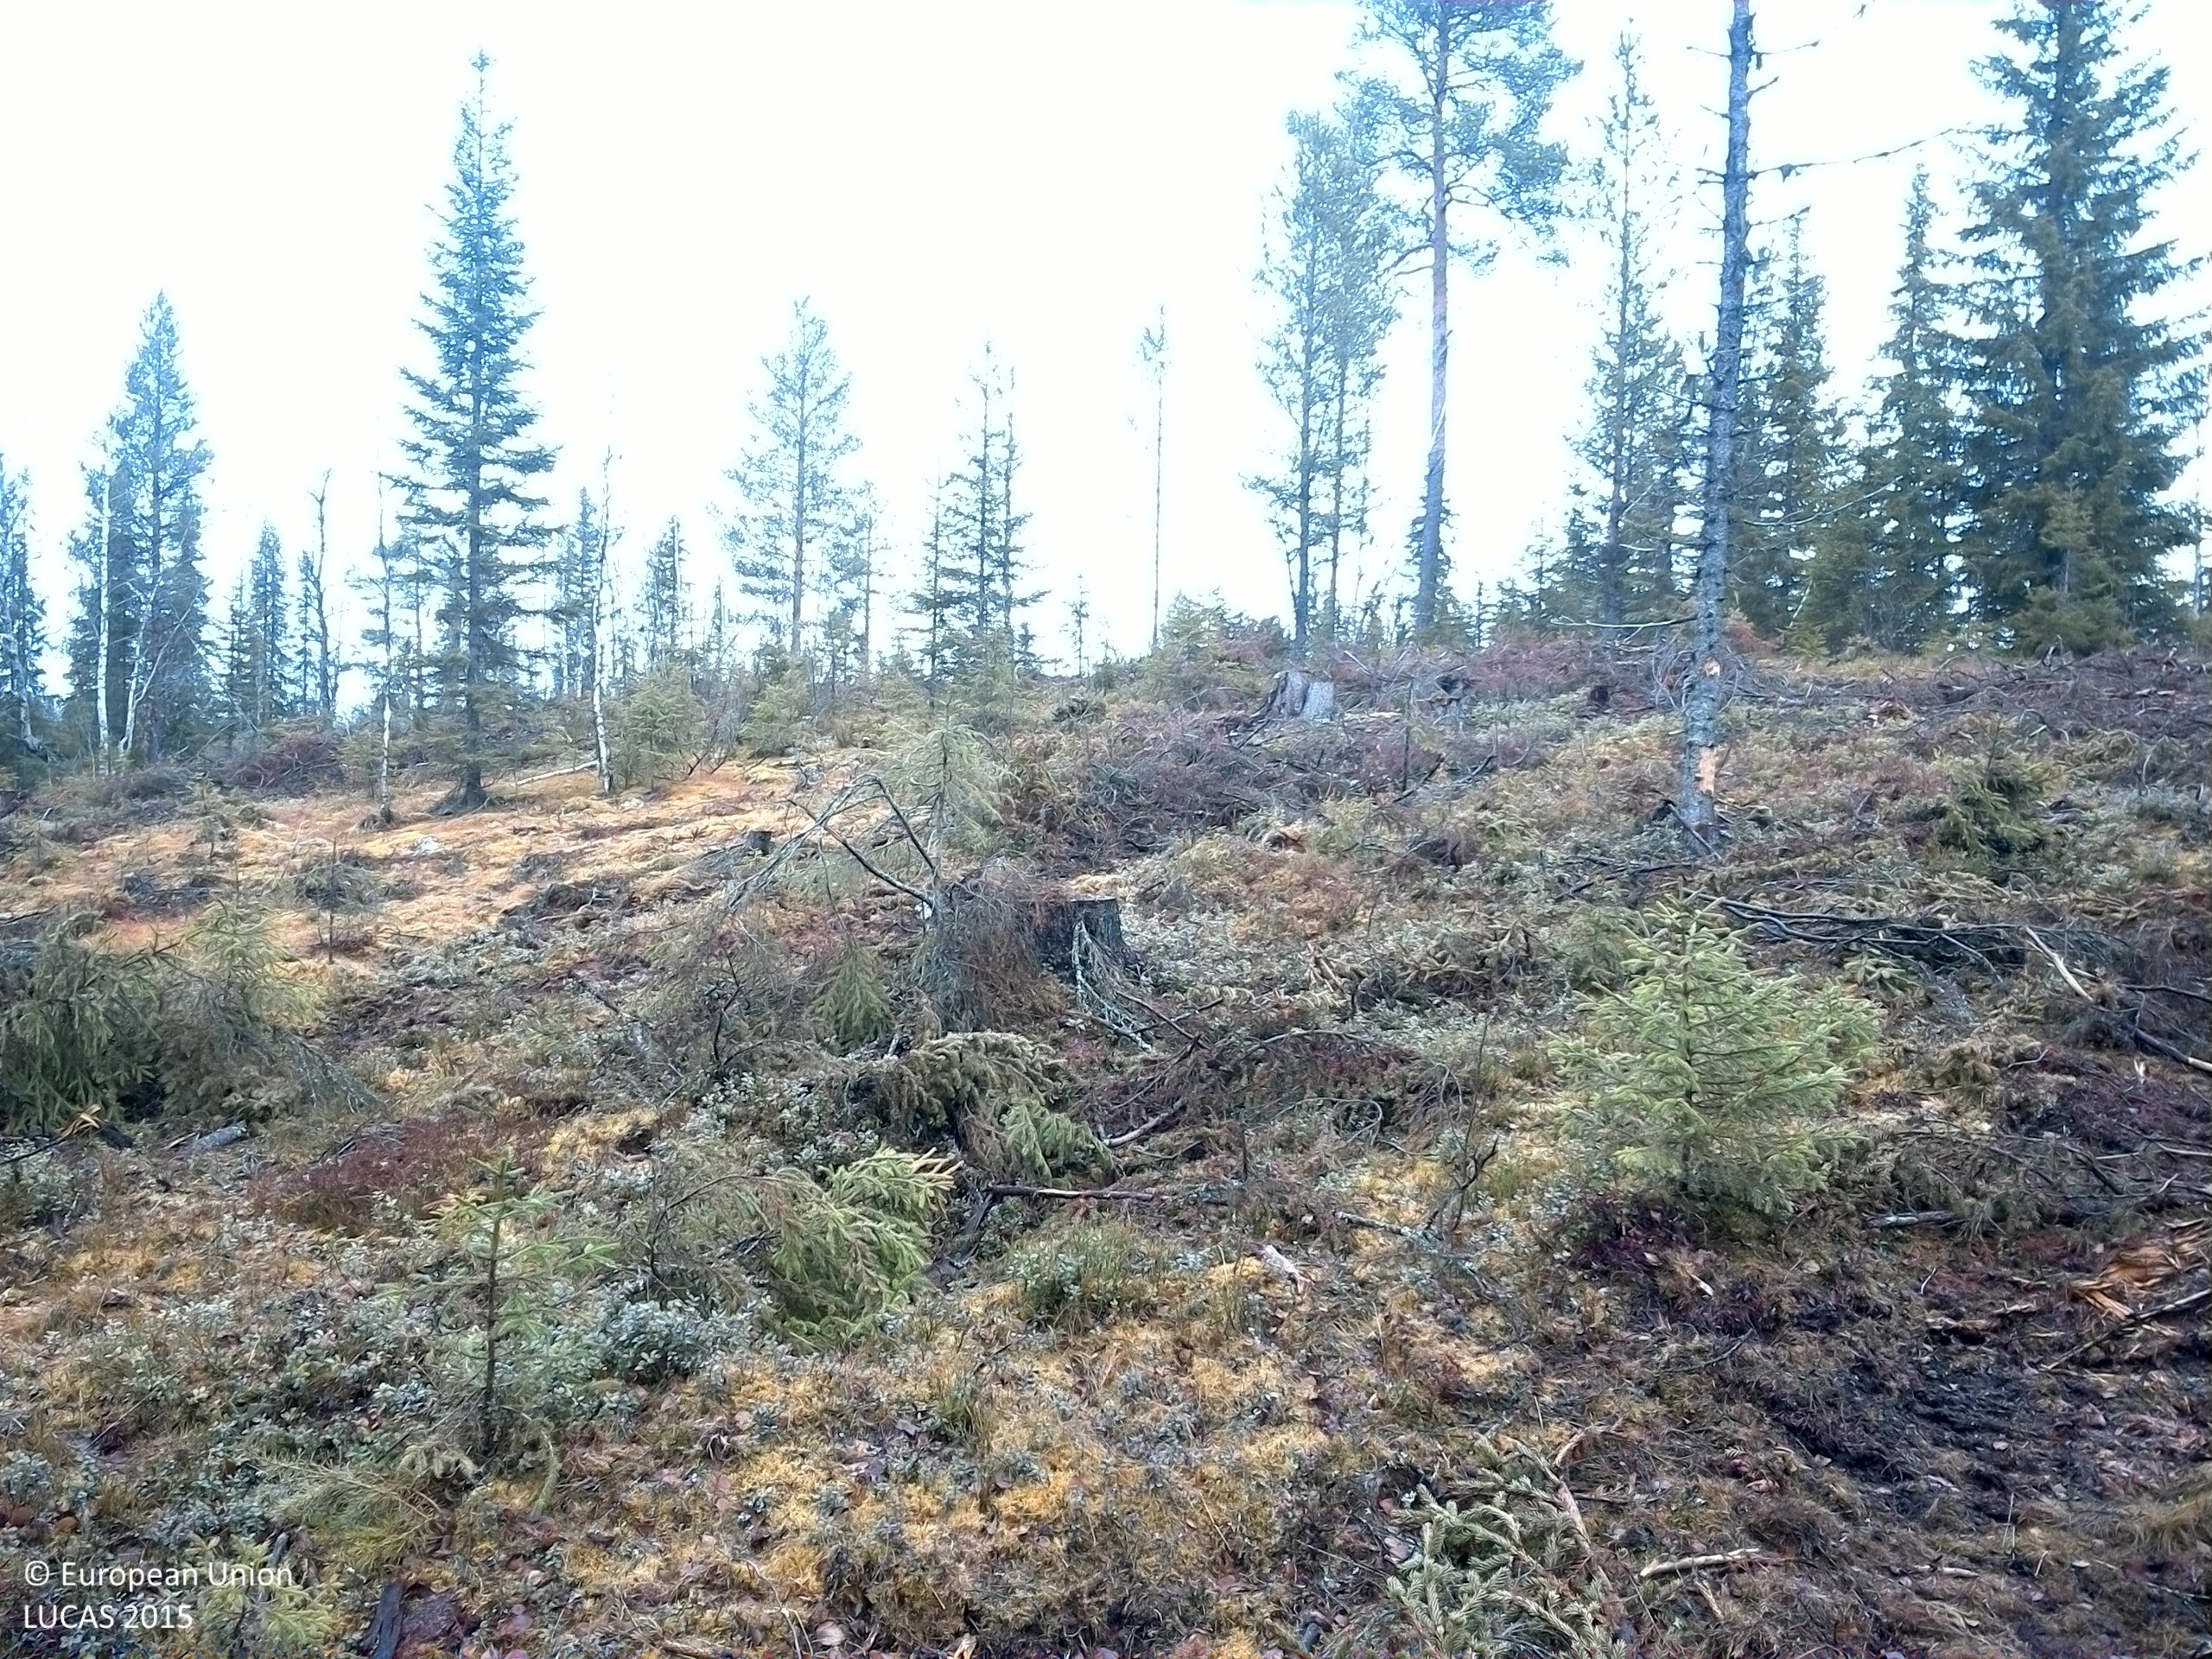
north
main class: Woodland
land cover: Spruce dominated mixed woodland
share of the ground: 10 - 25 %
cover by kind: lichens and mosses 30 %, shrubs 25 %, herbaceous plants 15 %, unconsolidated bare surface 15 %, coniferous forest trees 10 %, broadleaved forest trees 5 %
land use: Forestry
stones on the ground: 25 - 50 %
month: October
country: SE
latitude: 63.7885
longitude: 15.1897
